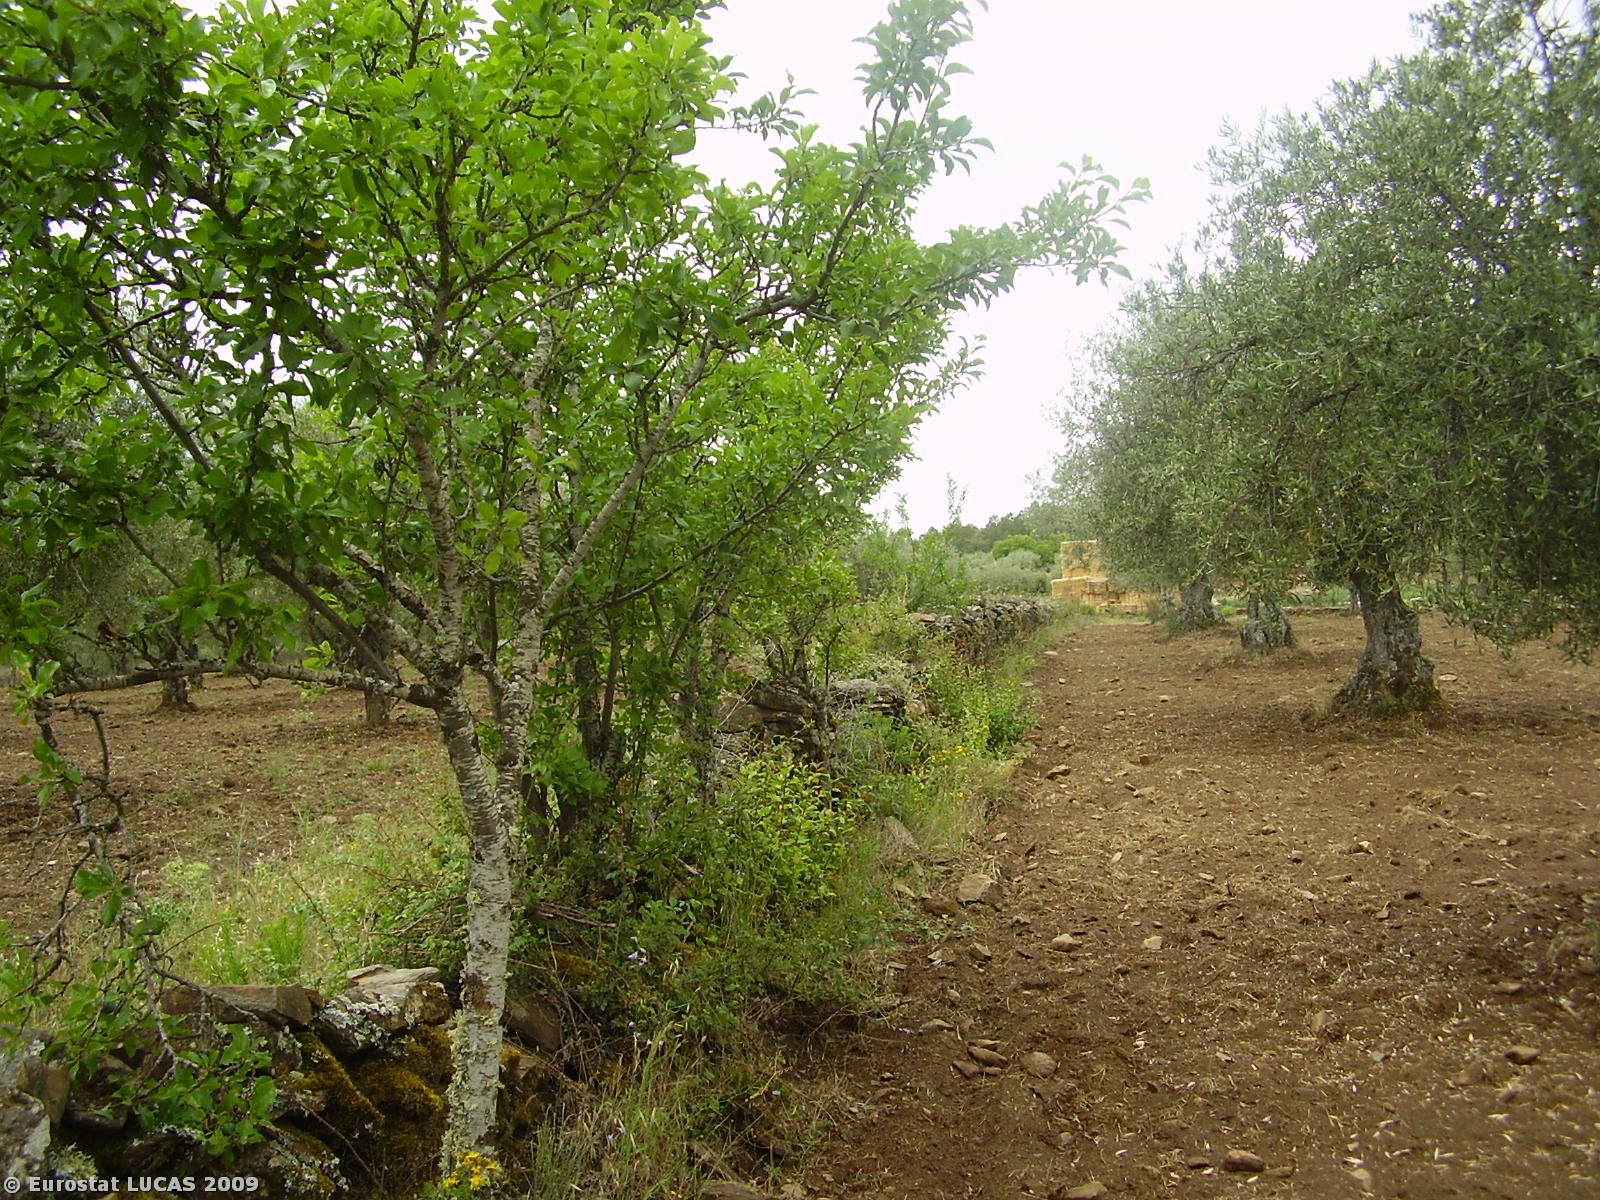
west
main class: Cropland
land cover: Olive groves
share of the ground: 10 - 25 %
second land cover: Bare land
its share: > 75 %
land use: Agriculture (excluding fallow land and kitchen gardens)
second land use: Unused
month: June
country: PT
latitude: 41.5540
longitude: -6.7875
